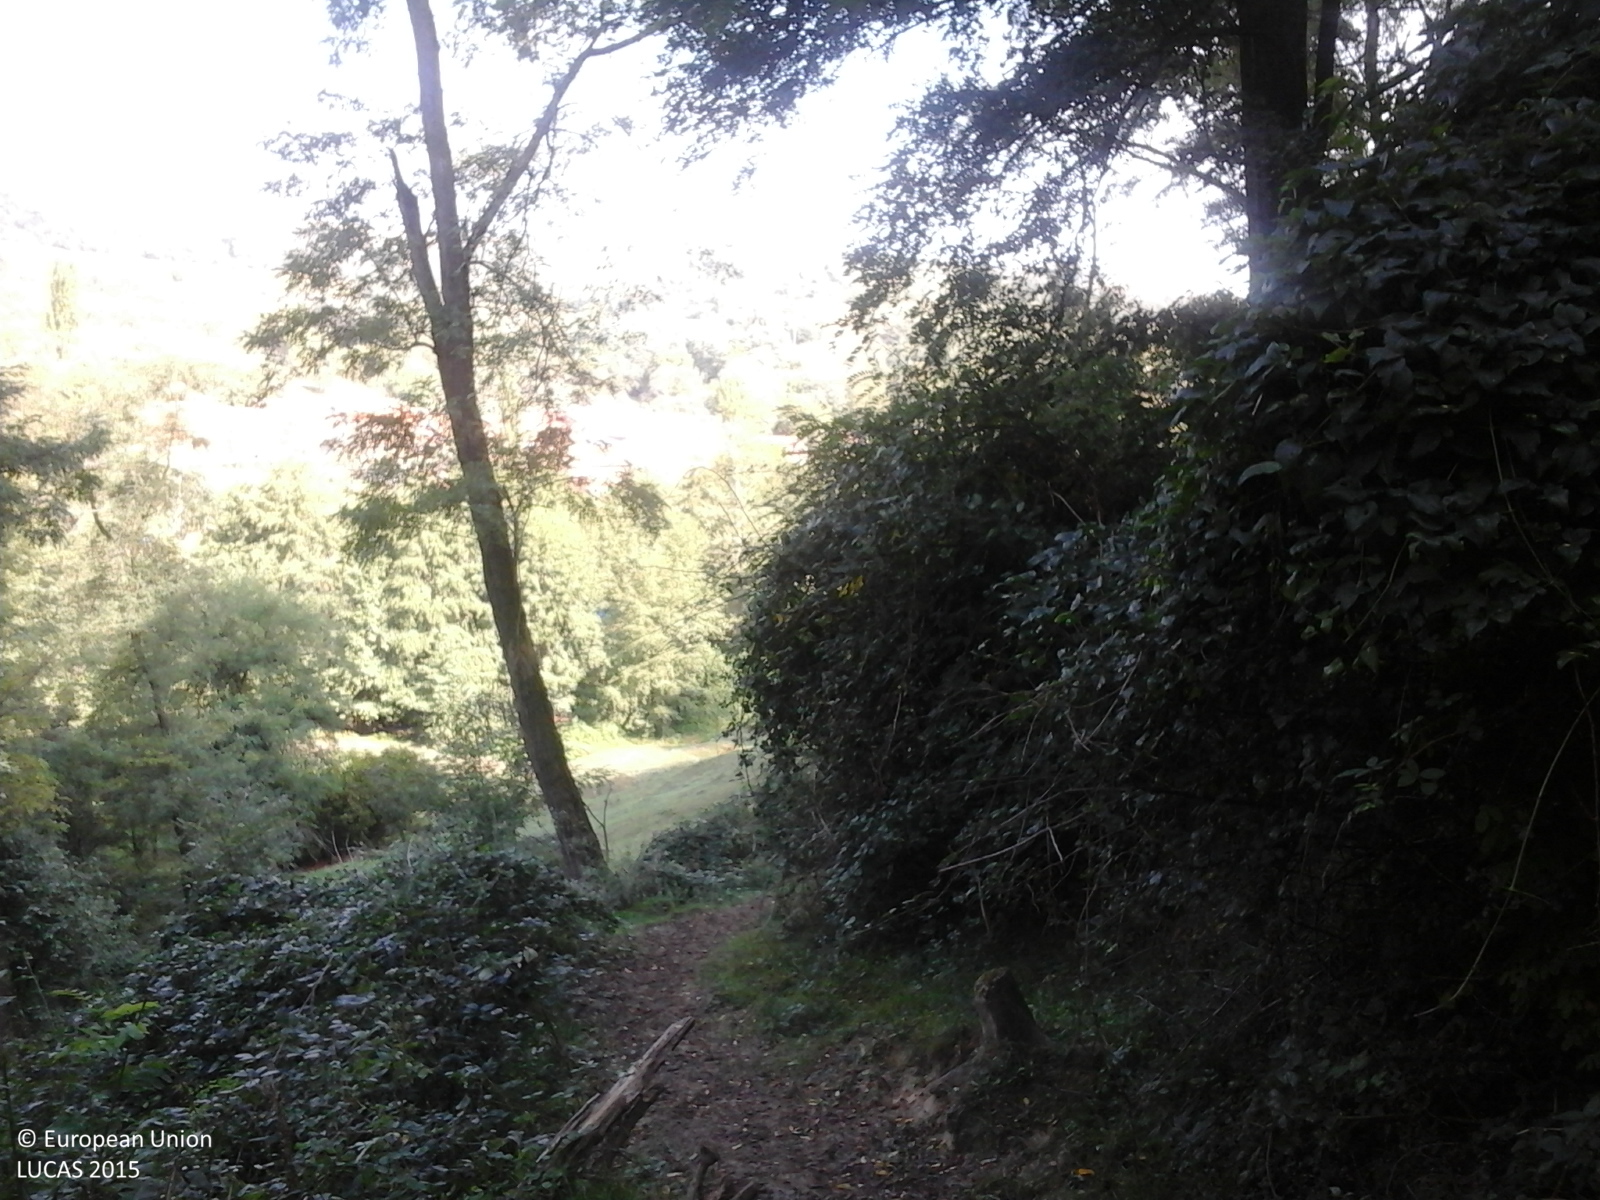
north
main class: Woodland
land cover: Broadleaved woodland
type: exotic forest
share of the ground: > 75 %
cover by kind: broadleaved forest trees 100 %
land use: Forestry
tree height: > 5 m
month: September
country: RO
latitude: 45.0887
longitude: 22.3264
